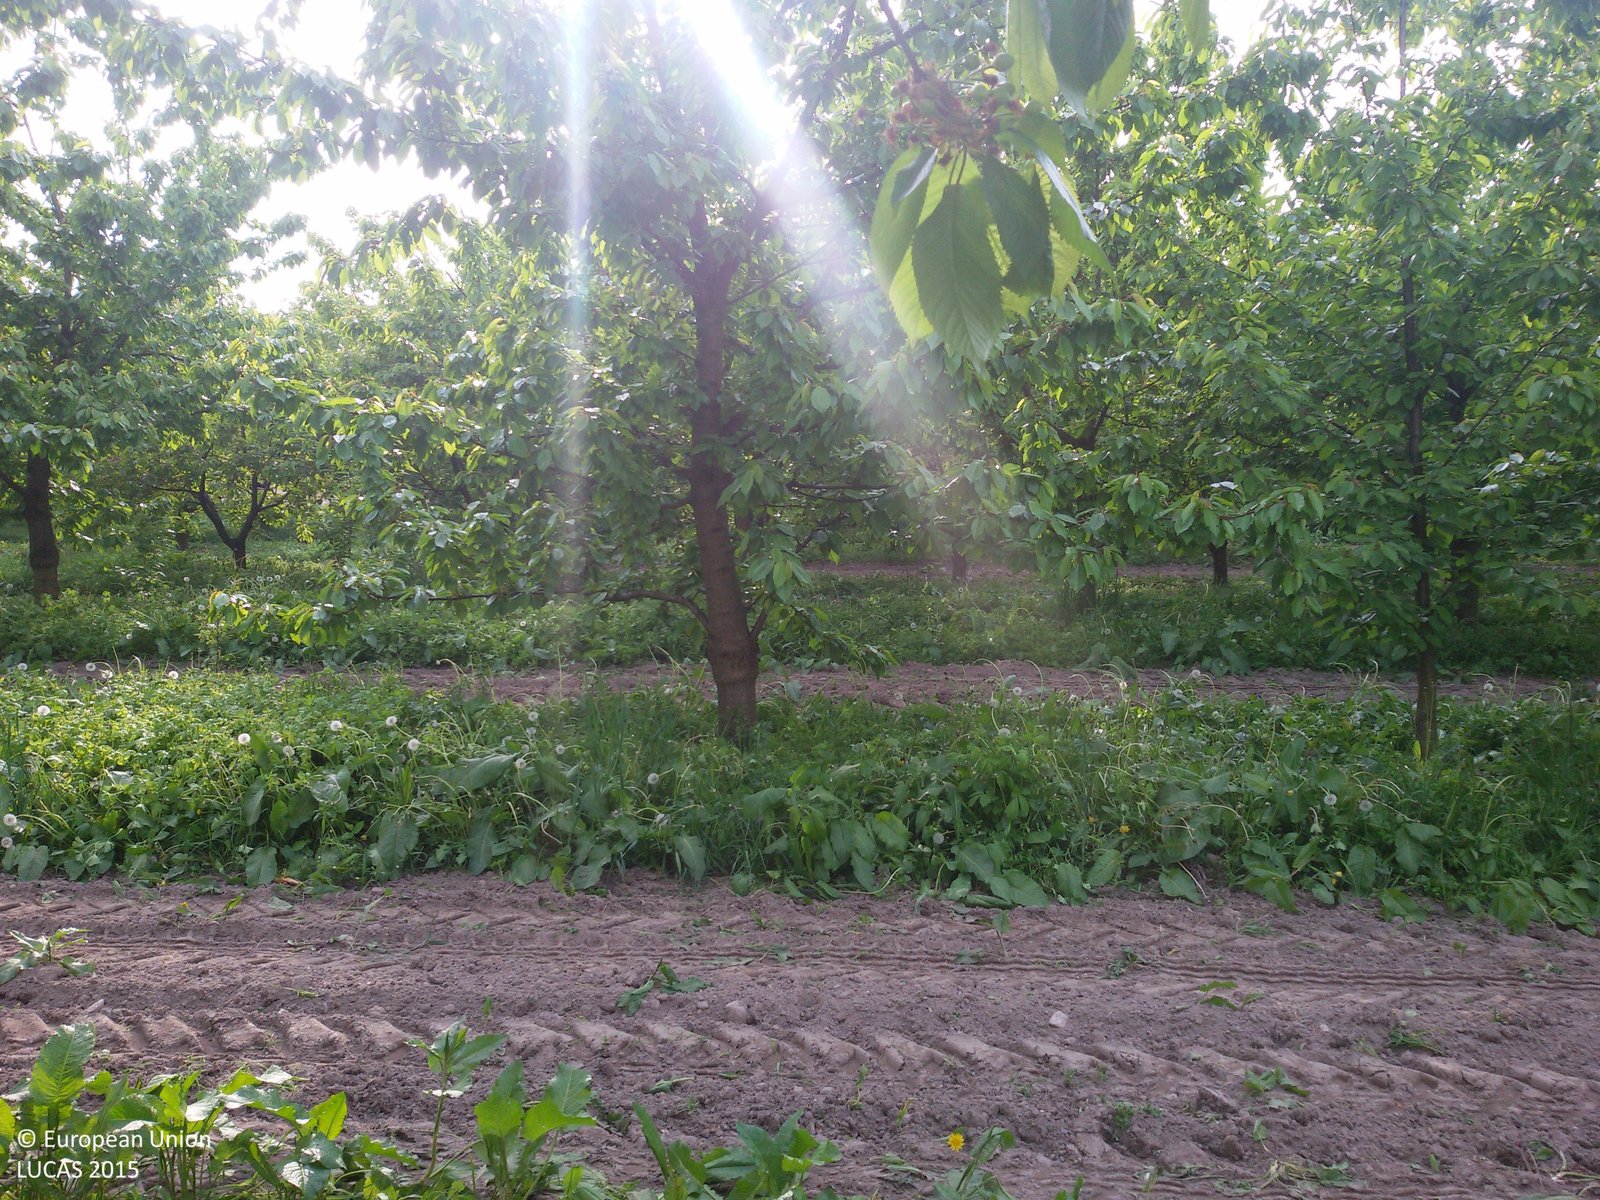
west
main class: Cropland
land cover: Cherry fruit
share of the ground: 50 - 75 %
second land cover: Grassland without tree/shrub cover
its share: > 75 %
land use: Agriculture (excluding fallow land and kitchen gardens)
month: May
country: PL
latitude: 51.9641
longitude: 20.7090
